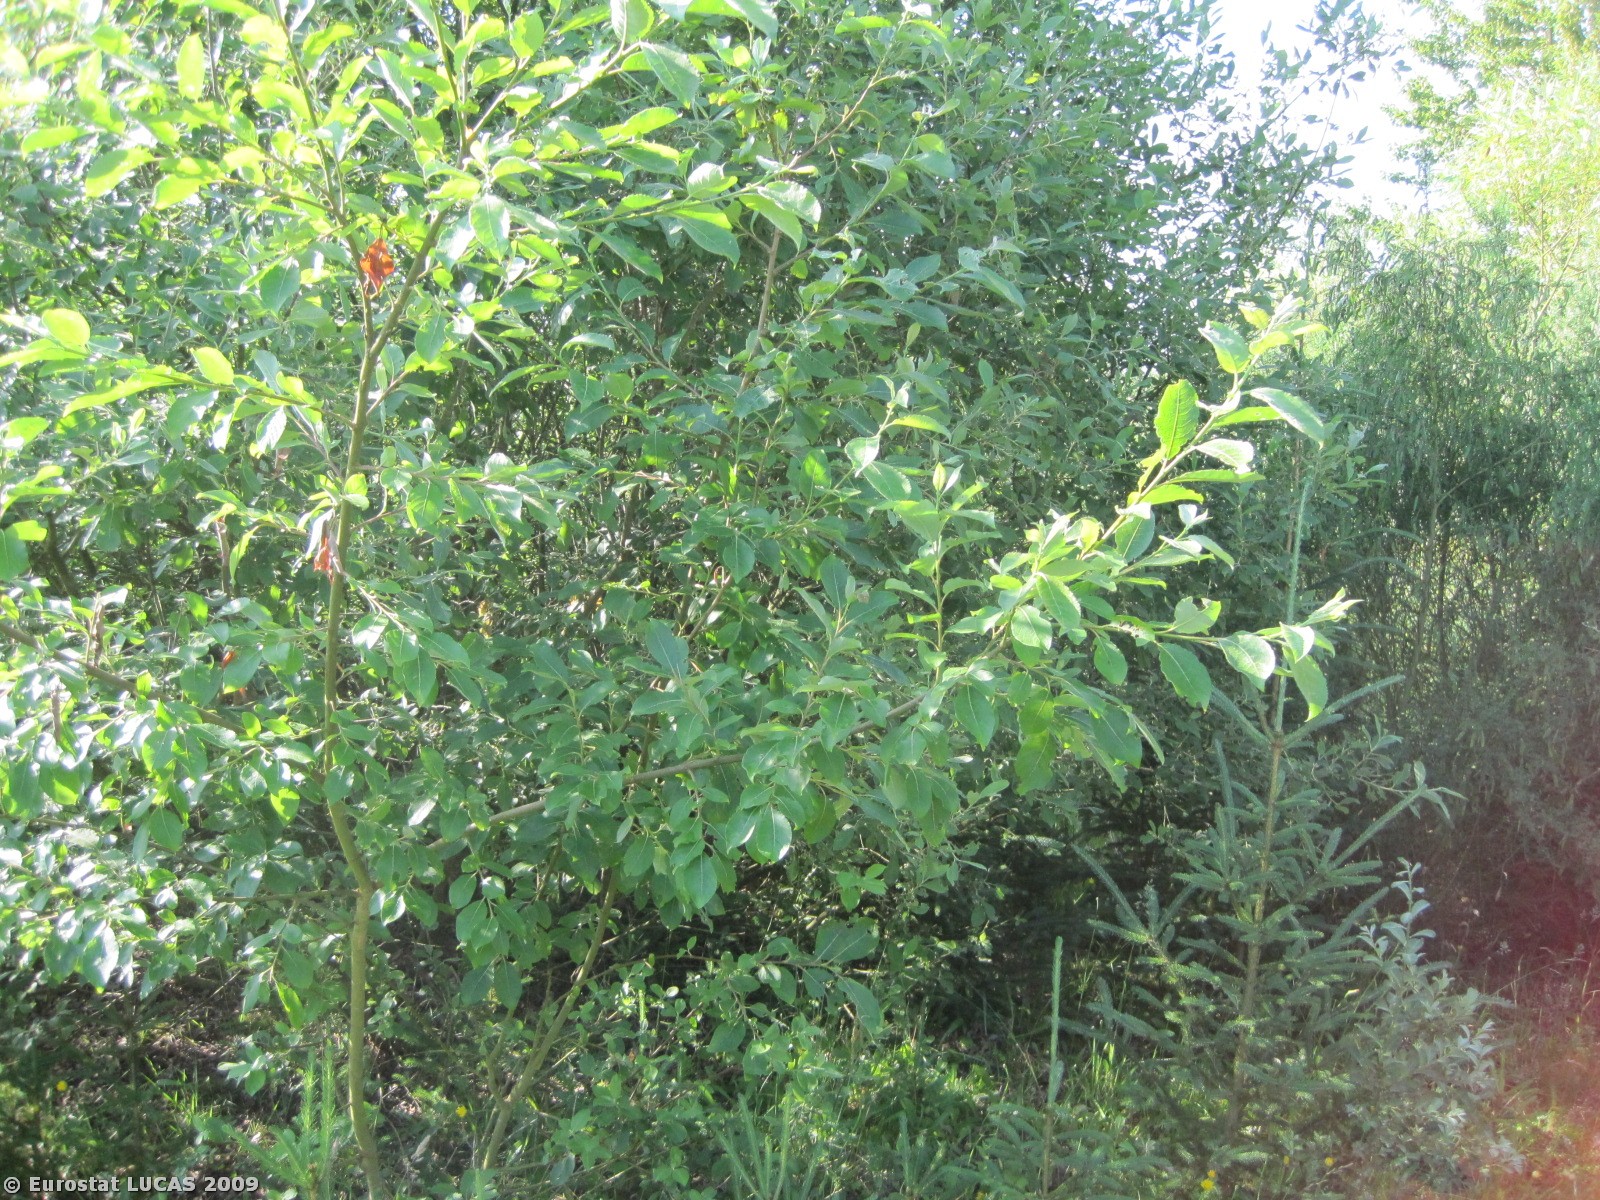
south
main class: Woodland
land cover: Mixed woodland
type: plantations and self-sown exotic forest
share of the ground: 25 - 50 %
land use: Forestry
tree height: > 5 m
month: July
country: DK
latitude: 56.4873
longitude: 8.7511
